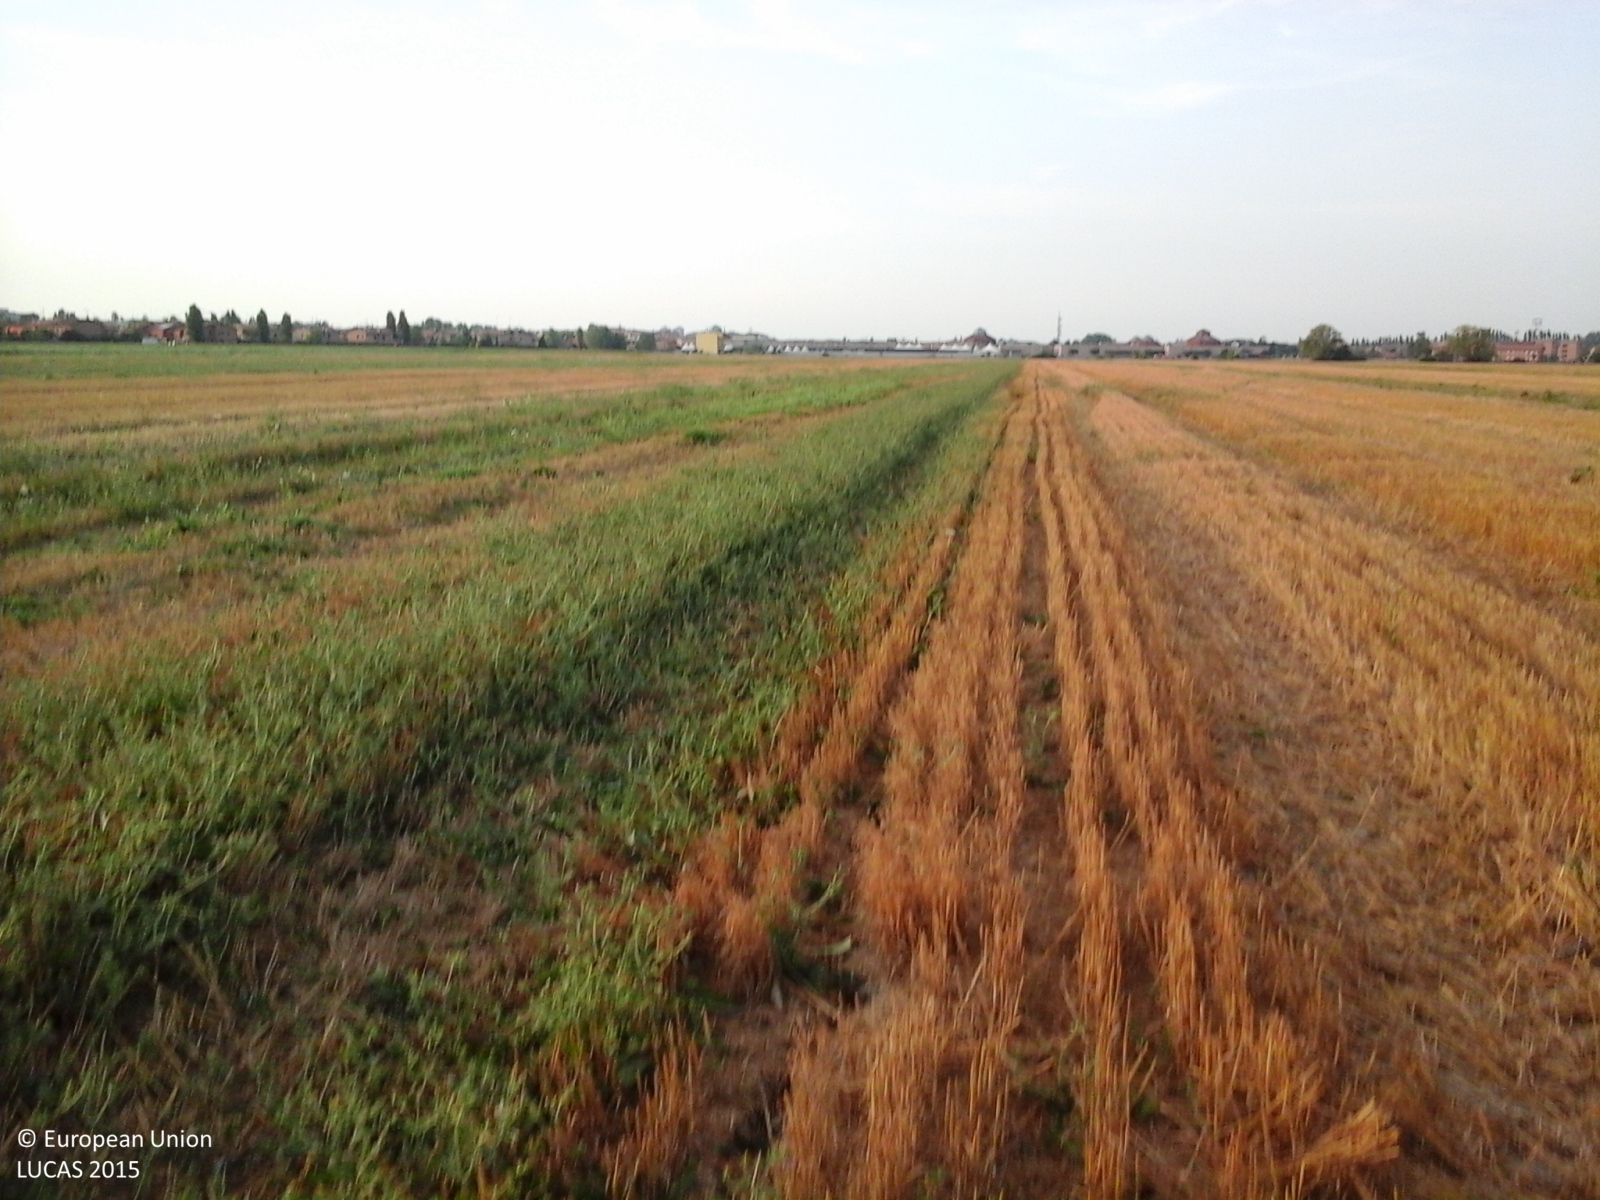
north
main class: Cropland
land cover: Common wheat
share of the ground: > 75 %
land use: Agriculture (excluding fallow land and kitchen gardens)
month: July
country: IT
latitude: 44.8071
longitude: 11.6025
